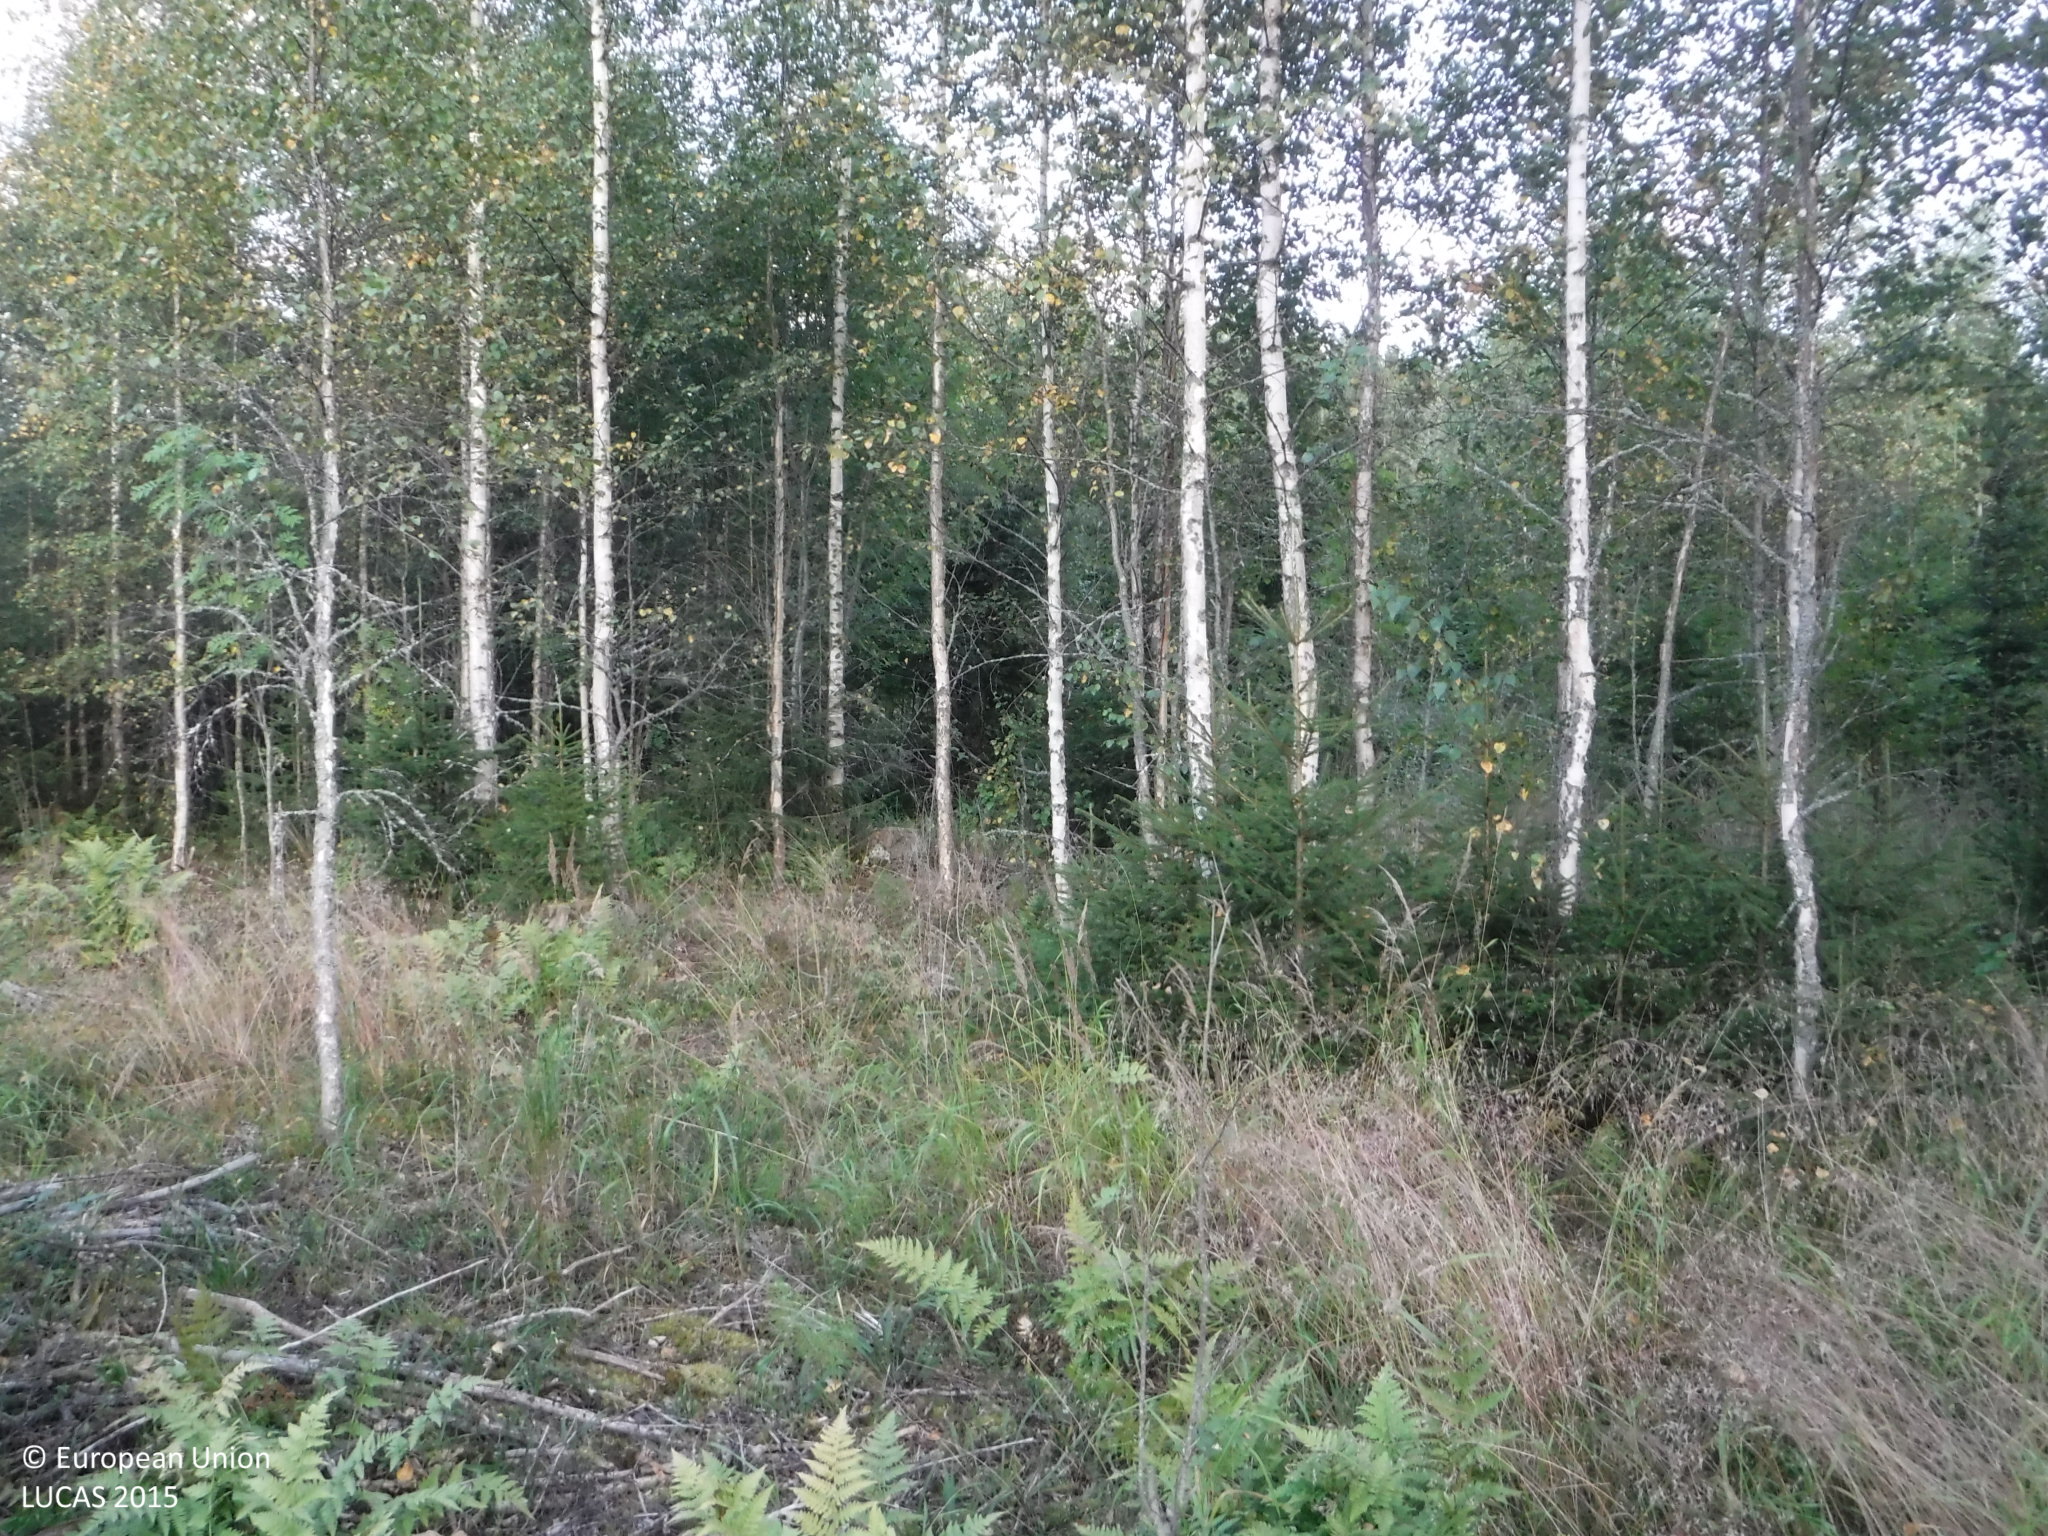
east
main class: Woodland
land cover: Spruce dominated mixed woodland
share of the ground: 50 - 75 %
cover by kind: coniferous forest trees 40 %, broadleaved forest trees 30 %, shrubs 10 %, lichens and mosses 10 %
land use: Forestry
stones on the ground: < 10 %
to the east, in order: Spruce dominated mixed woodland; Broadleaved woodland; Spruce dominated mixed woodland; Ditches and canals; Grassland with sparse tree/shrub cover; Ditches and canals; Spruce dominated coniferous woodland; Broadleaved woodland; Pine dominated mixed woodland; Ditches and canals; Pine dominated mixed woodland
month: August
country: FI
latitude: 61.1820
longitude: 23.0362
